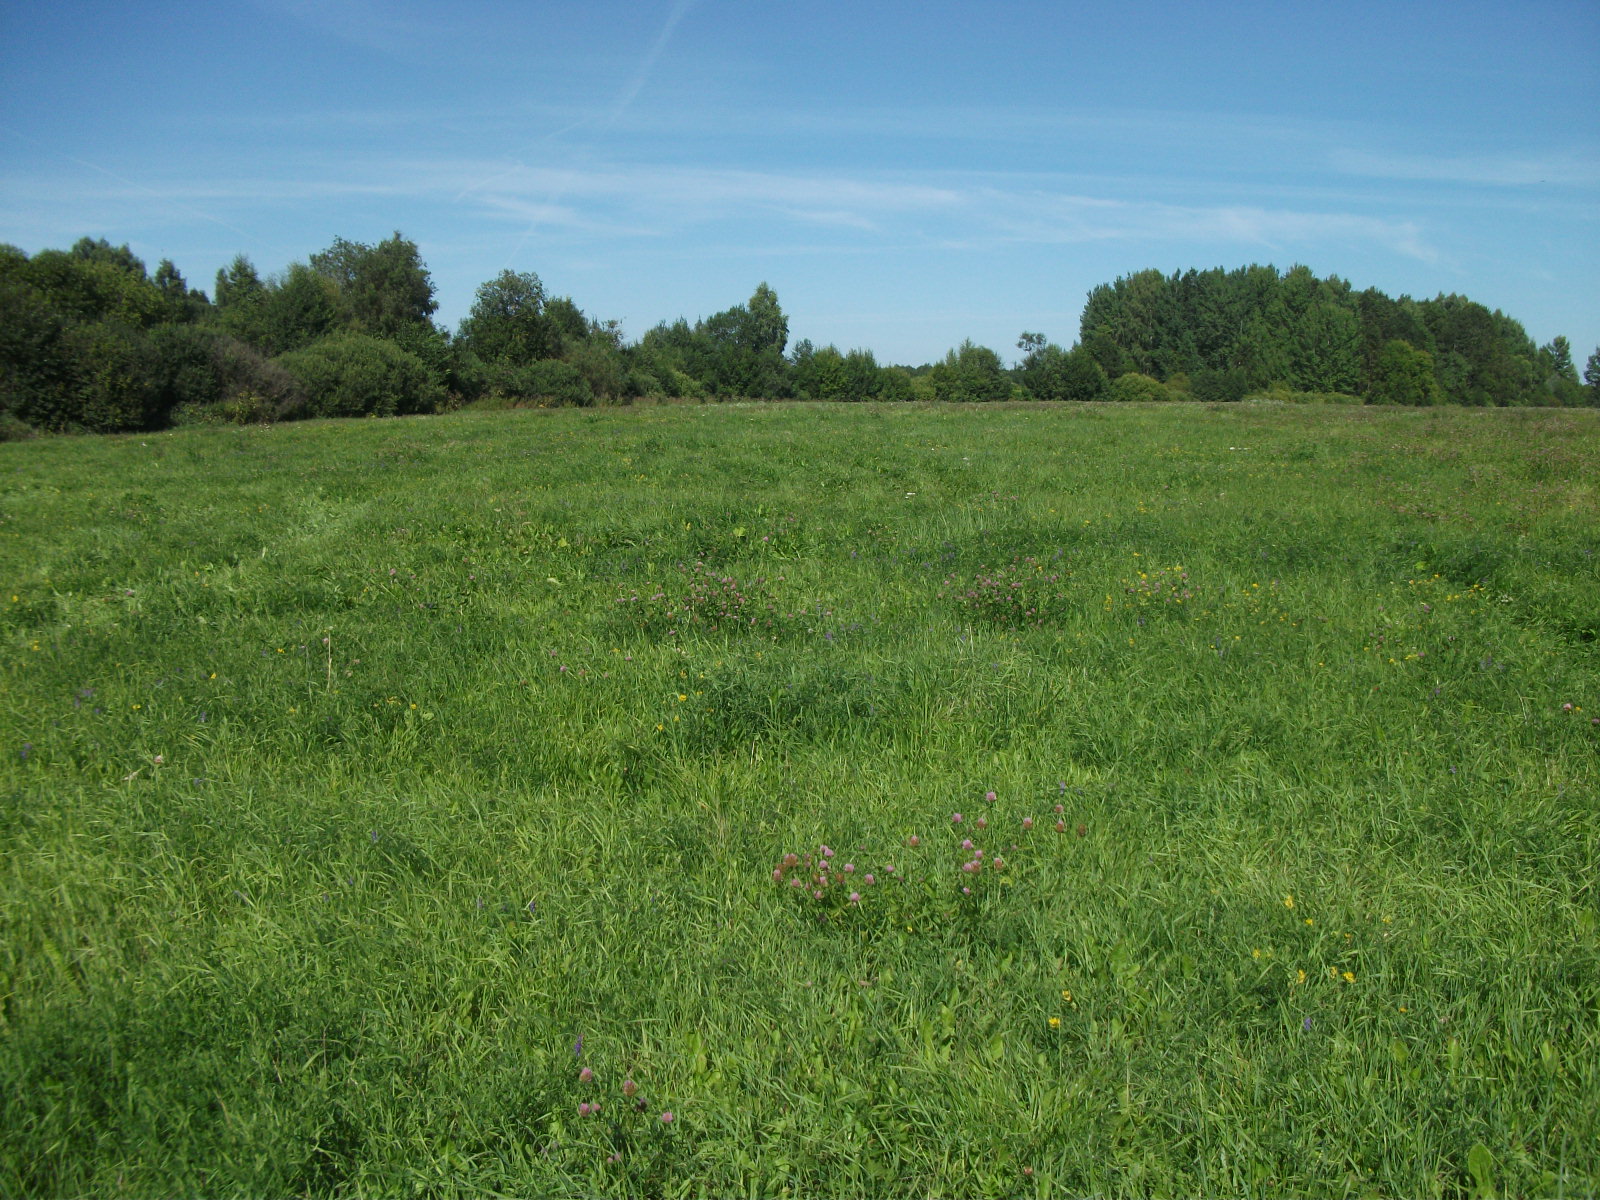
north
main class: Grassland
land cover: Grassland without tree/shrub cover
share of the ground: > 75 %
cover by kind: herbaceous plants 100 %
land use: Agriculture (excluding fallow land and kitchen gardens)
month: August
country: LV
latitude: 56.2270
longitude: 26.3883
